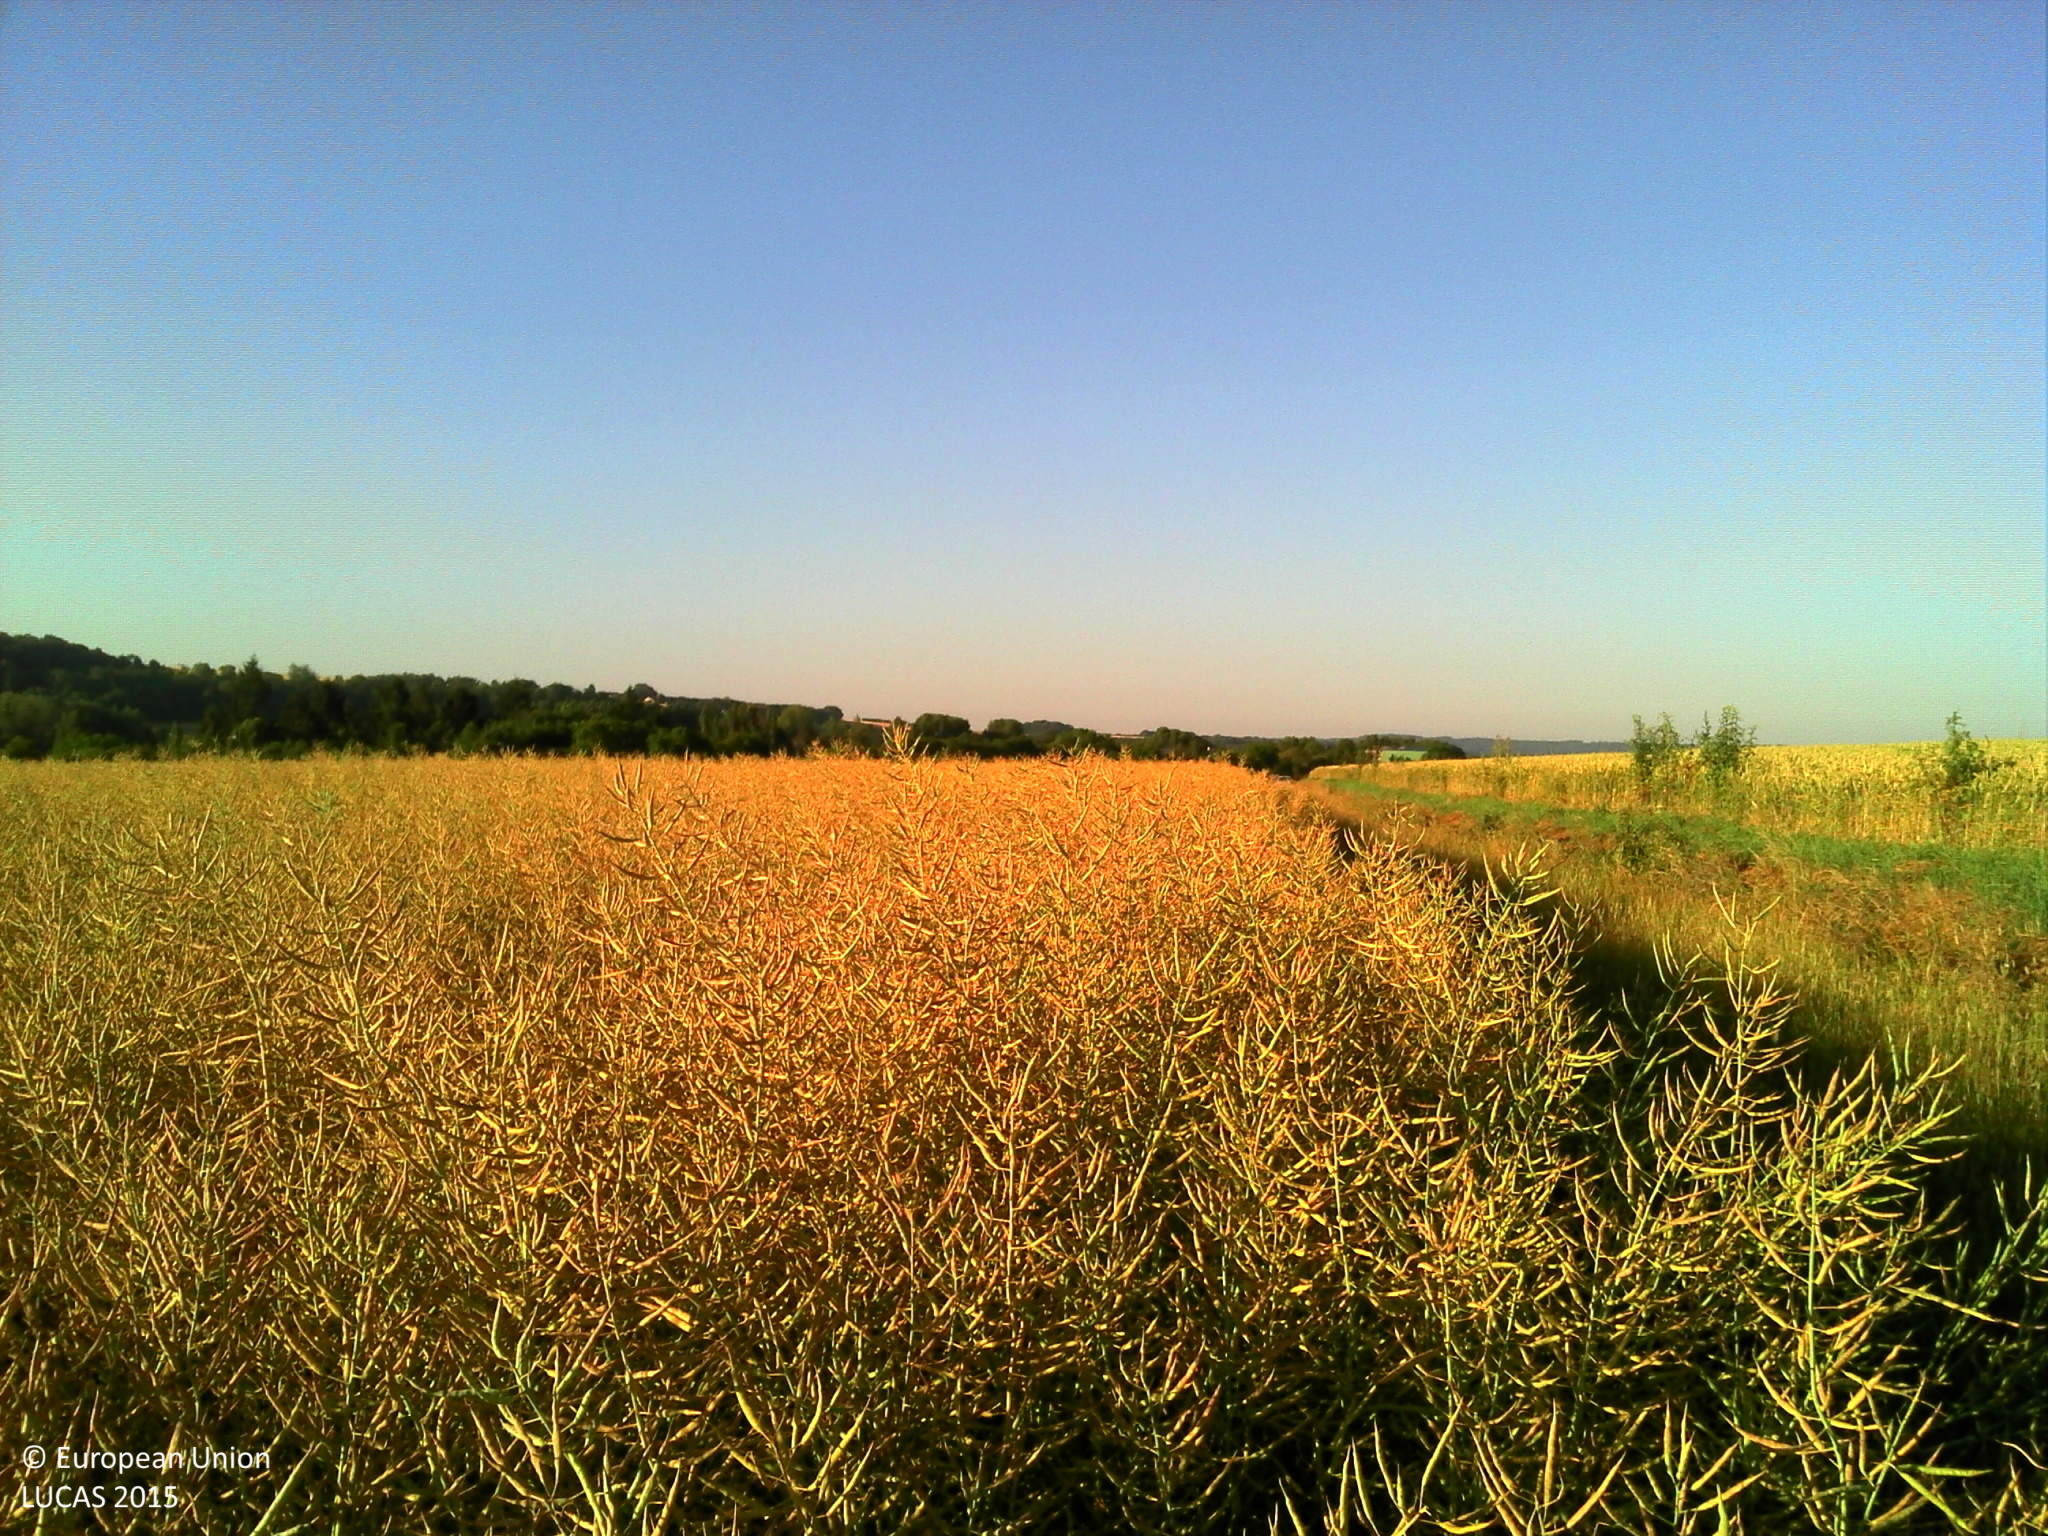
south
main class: Cropland
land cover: Rape and turnip rape
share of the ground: > 75 %
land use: Agriculture (excluding fallow land and kitchen gardens)
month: June
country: FR
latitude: 49.4437
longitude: 2.4157
